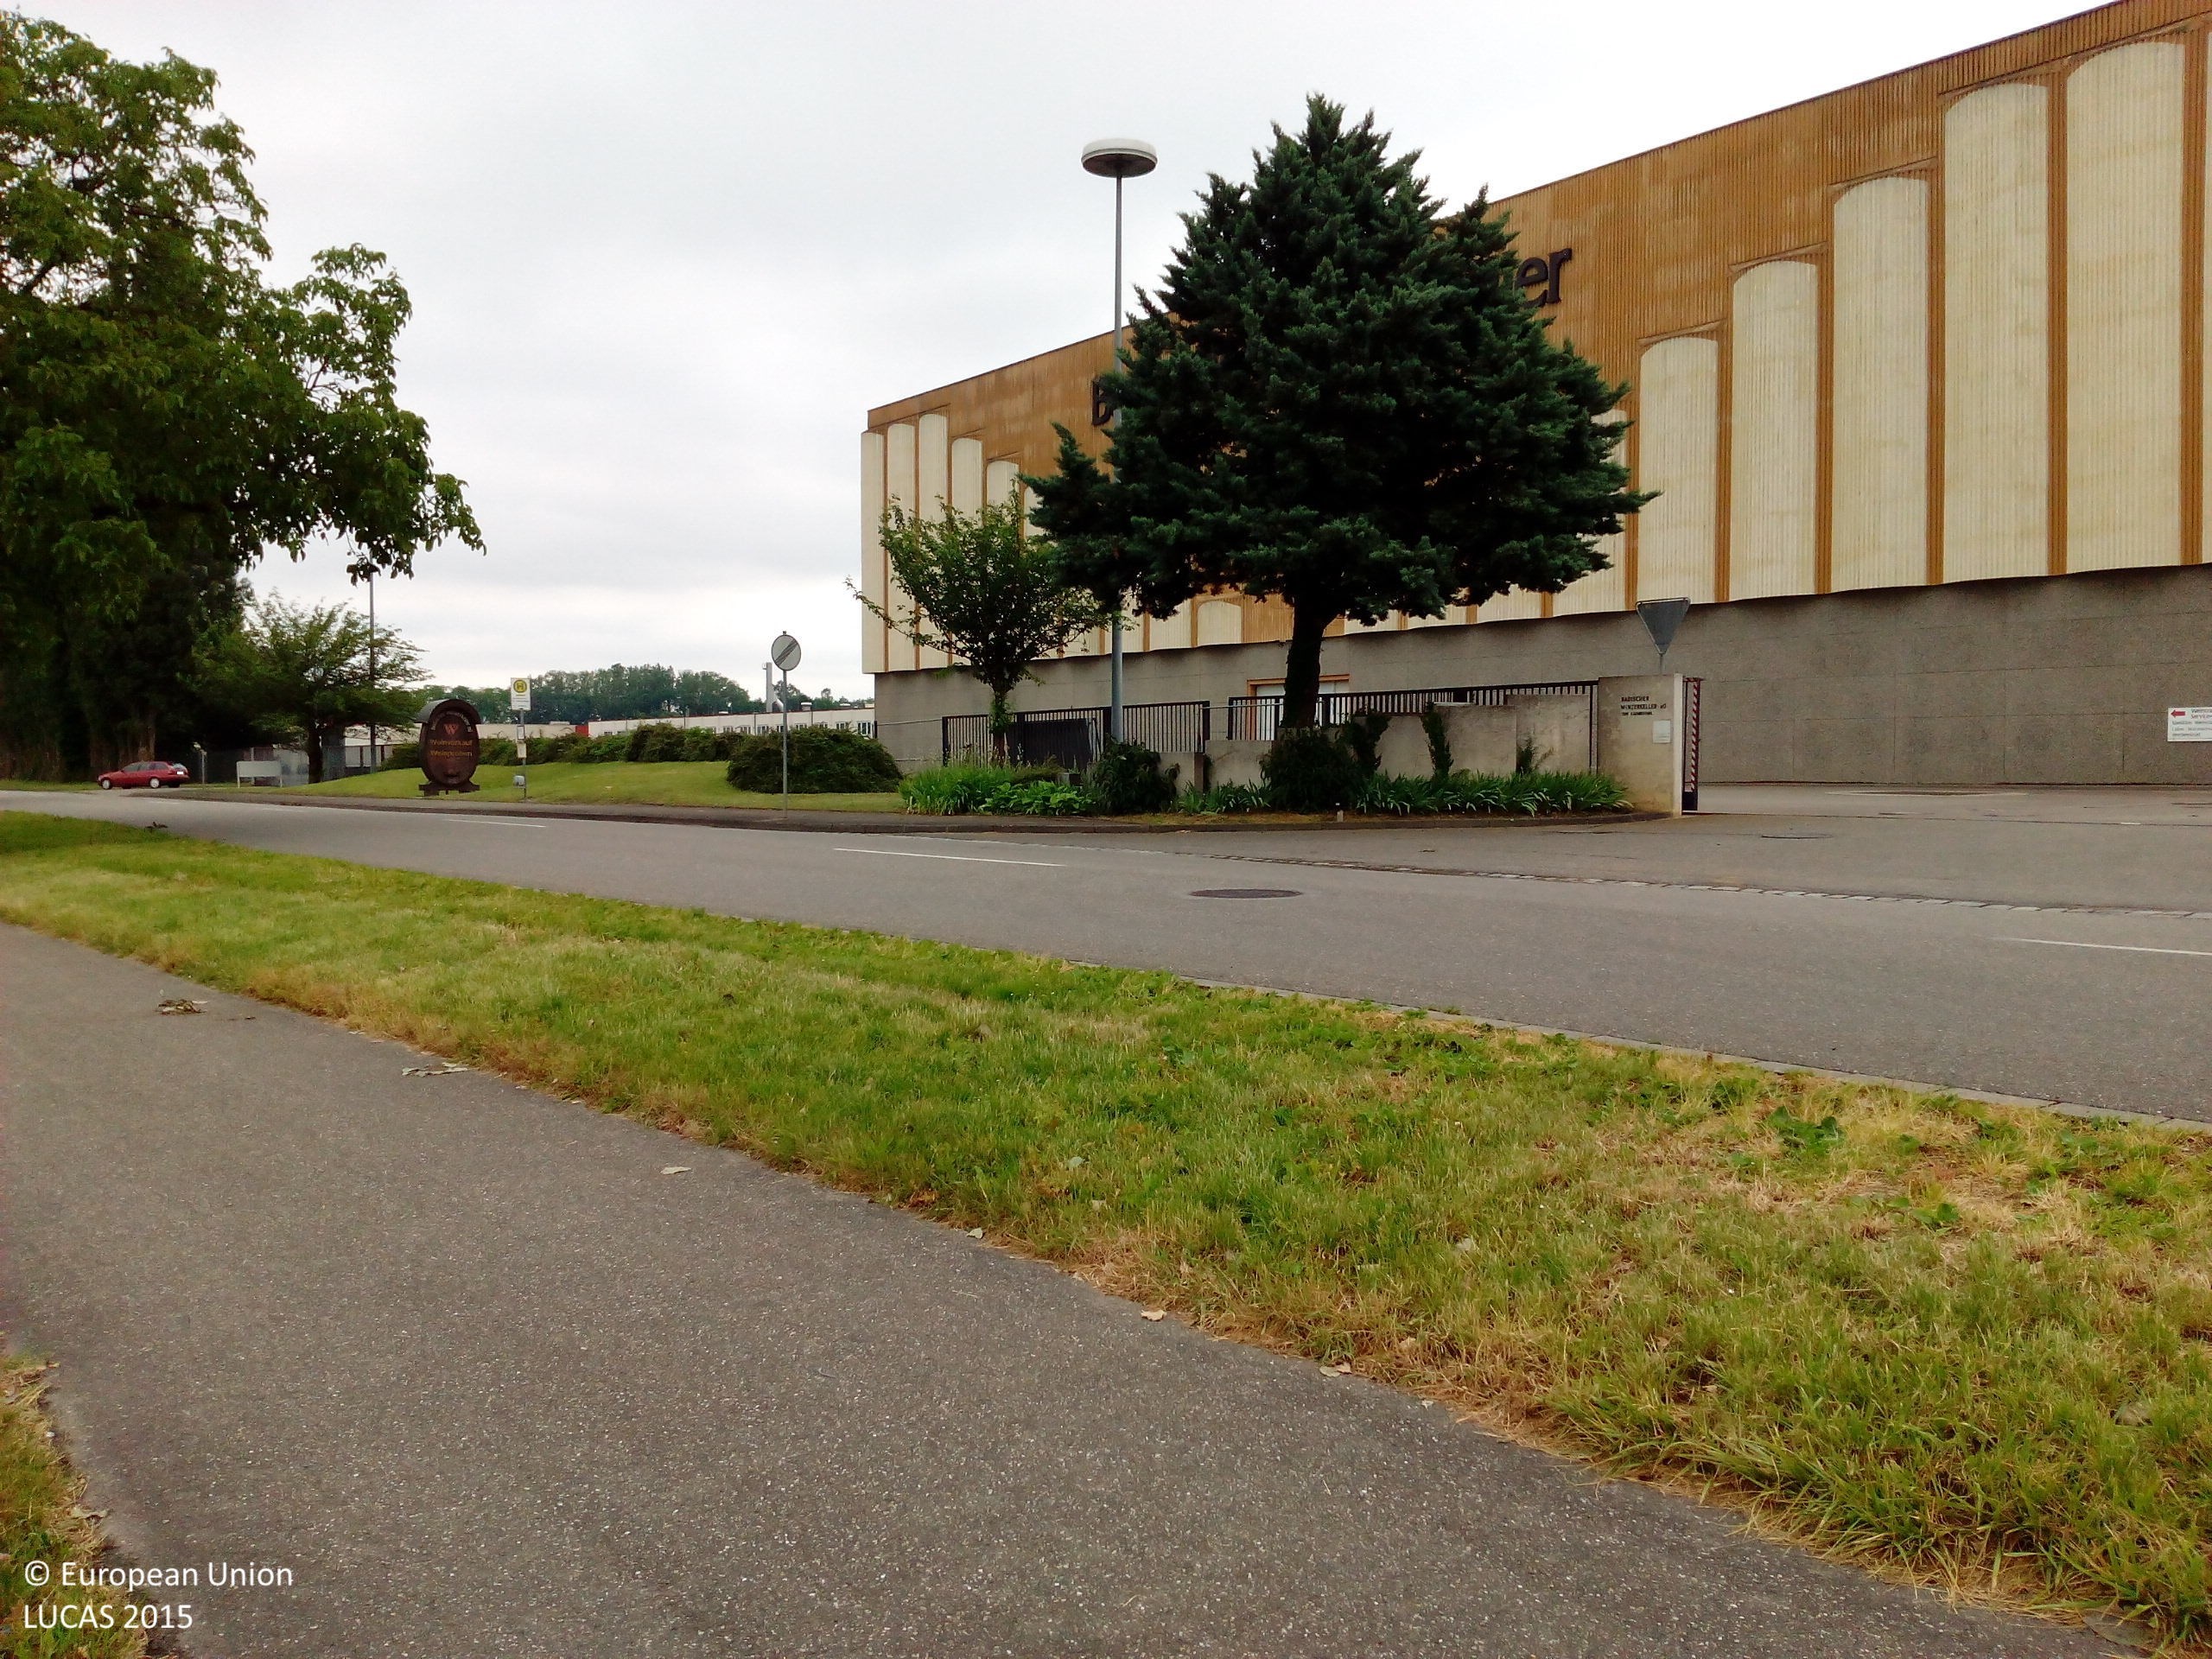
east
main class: Cropland
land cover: Durum wheat
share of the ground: > 75 %
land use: Agriculture (excluding fallow land and kitchen gardens)
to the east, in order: Durum wheat; Paved roads, cycling and walking lanes; Grass margins; Single bushes/trees; Paved roads, cycling and walking lanes; Grassland without tree/shrub cover; Single bushes/trees; Artificial constructions in urban areas
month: June
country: DE
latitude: 48.0354
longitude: 7.6005
